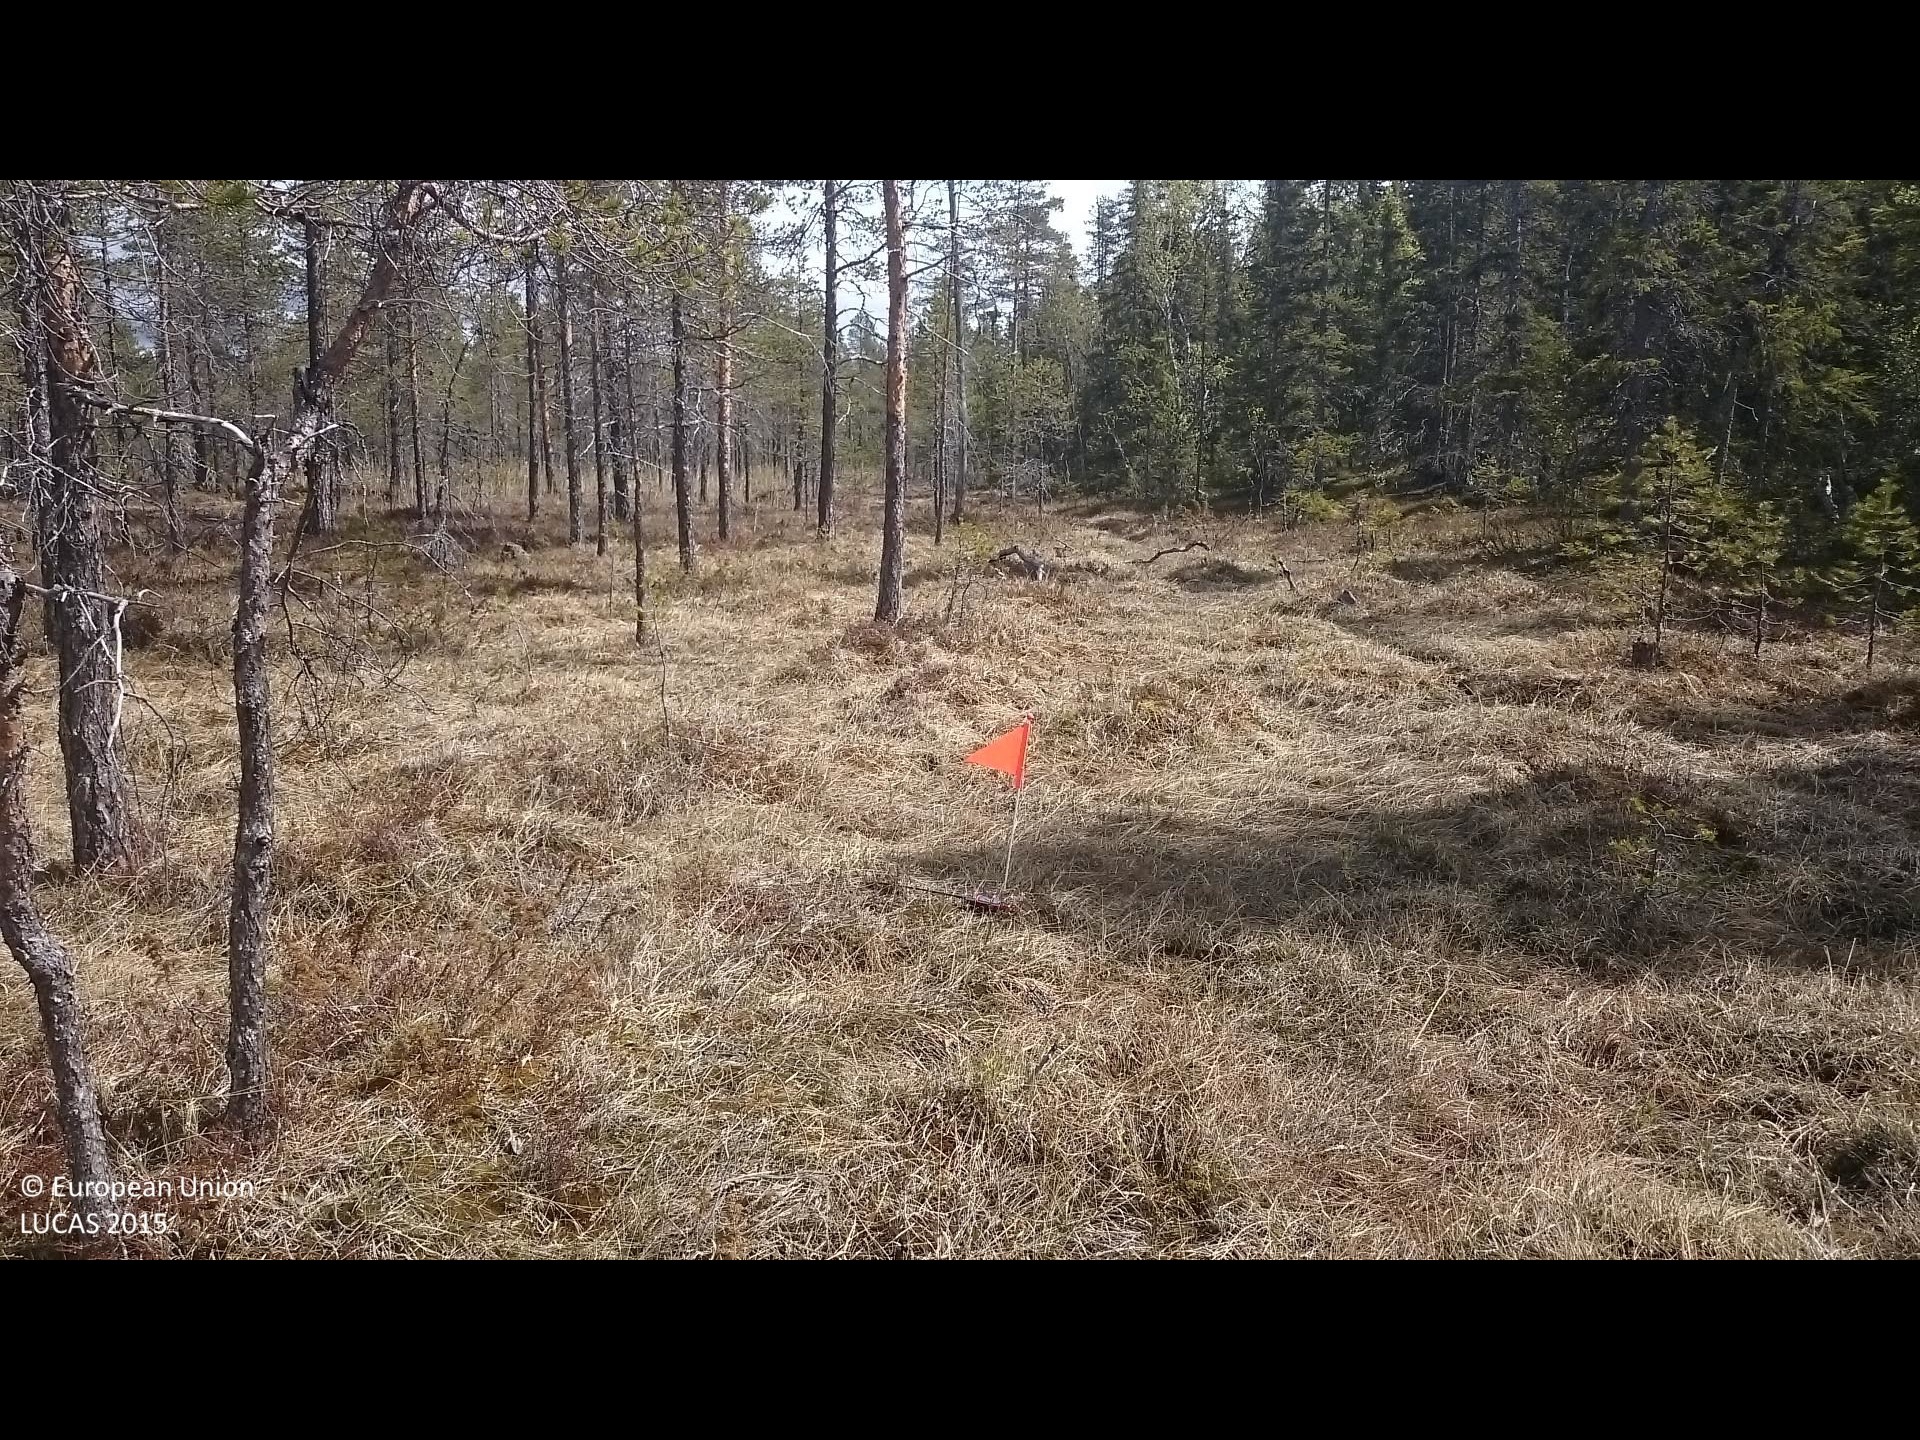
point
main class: Woodland
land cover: Pine dominated coniferous woodland
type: boreal forest
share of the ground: 50 - 75 %
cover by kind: coniferous forest trees 75 %, shrubs 25 %
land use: Forestry
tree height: > 5 m
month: June
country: SE
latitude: 63.5929
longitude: 13.8292
